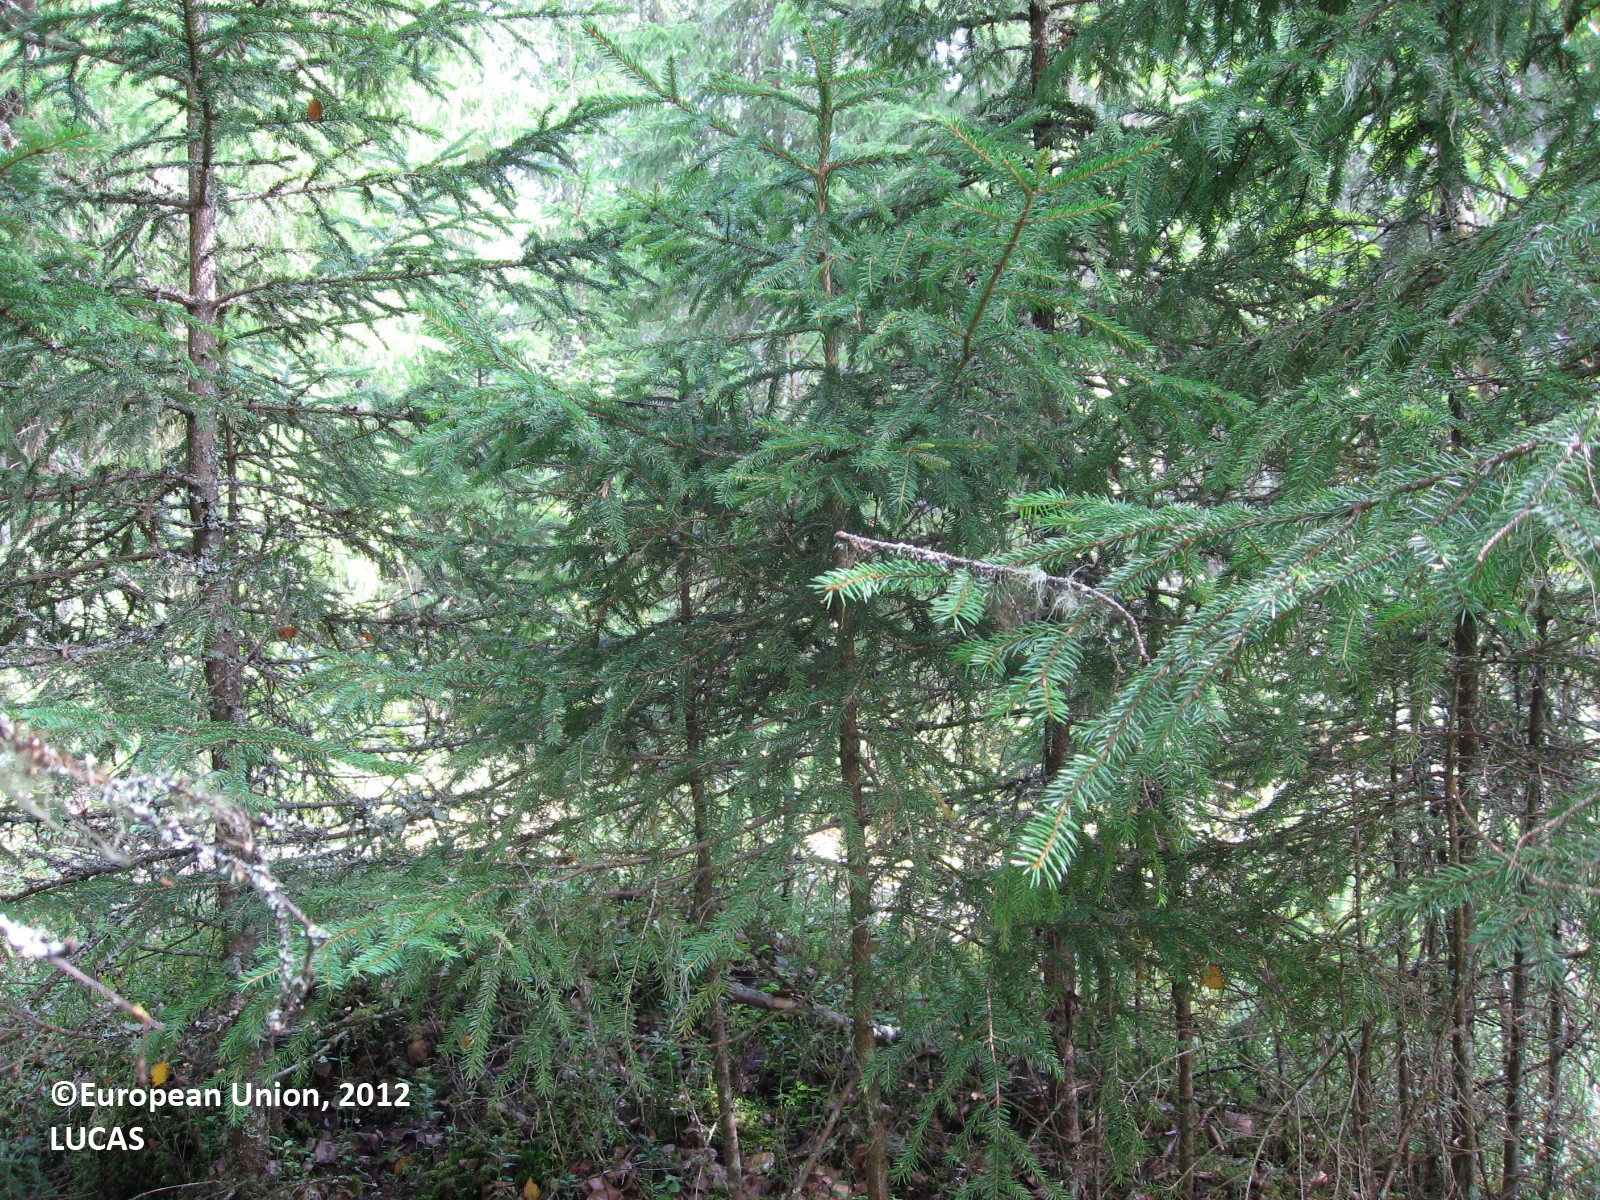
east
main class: Woodland
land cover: Spruce dominated mixed woodland
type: boreal forest
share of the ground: > 75 %
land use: Forestry
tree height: > 5 m
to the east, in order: Spruce dominated mixed woodland; Broadleaved woodland; Spruce dominated mixed woodland; Spontaneously vegetated surfaces; Spruce dominated coniferous woodland; Spontaneously vegetated surfaces; Spruce dominated mixed woodland; Other mixed woodland; Spruce dominated mixed woodland
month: August
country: FI
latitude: 61.3323
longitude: 24.8892
